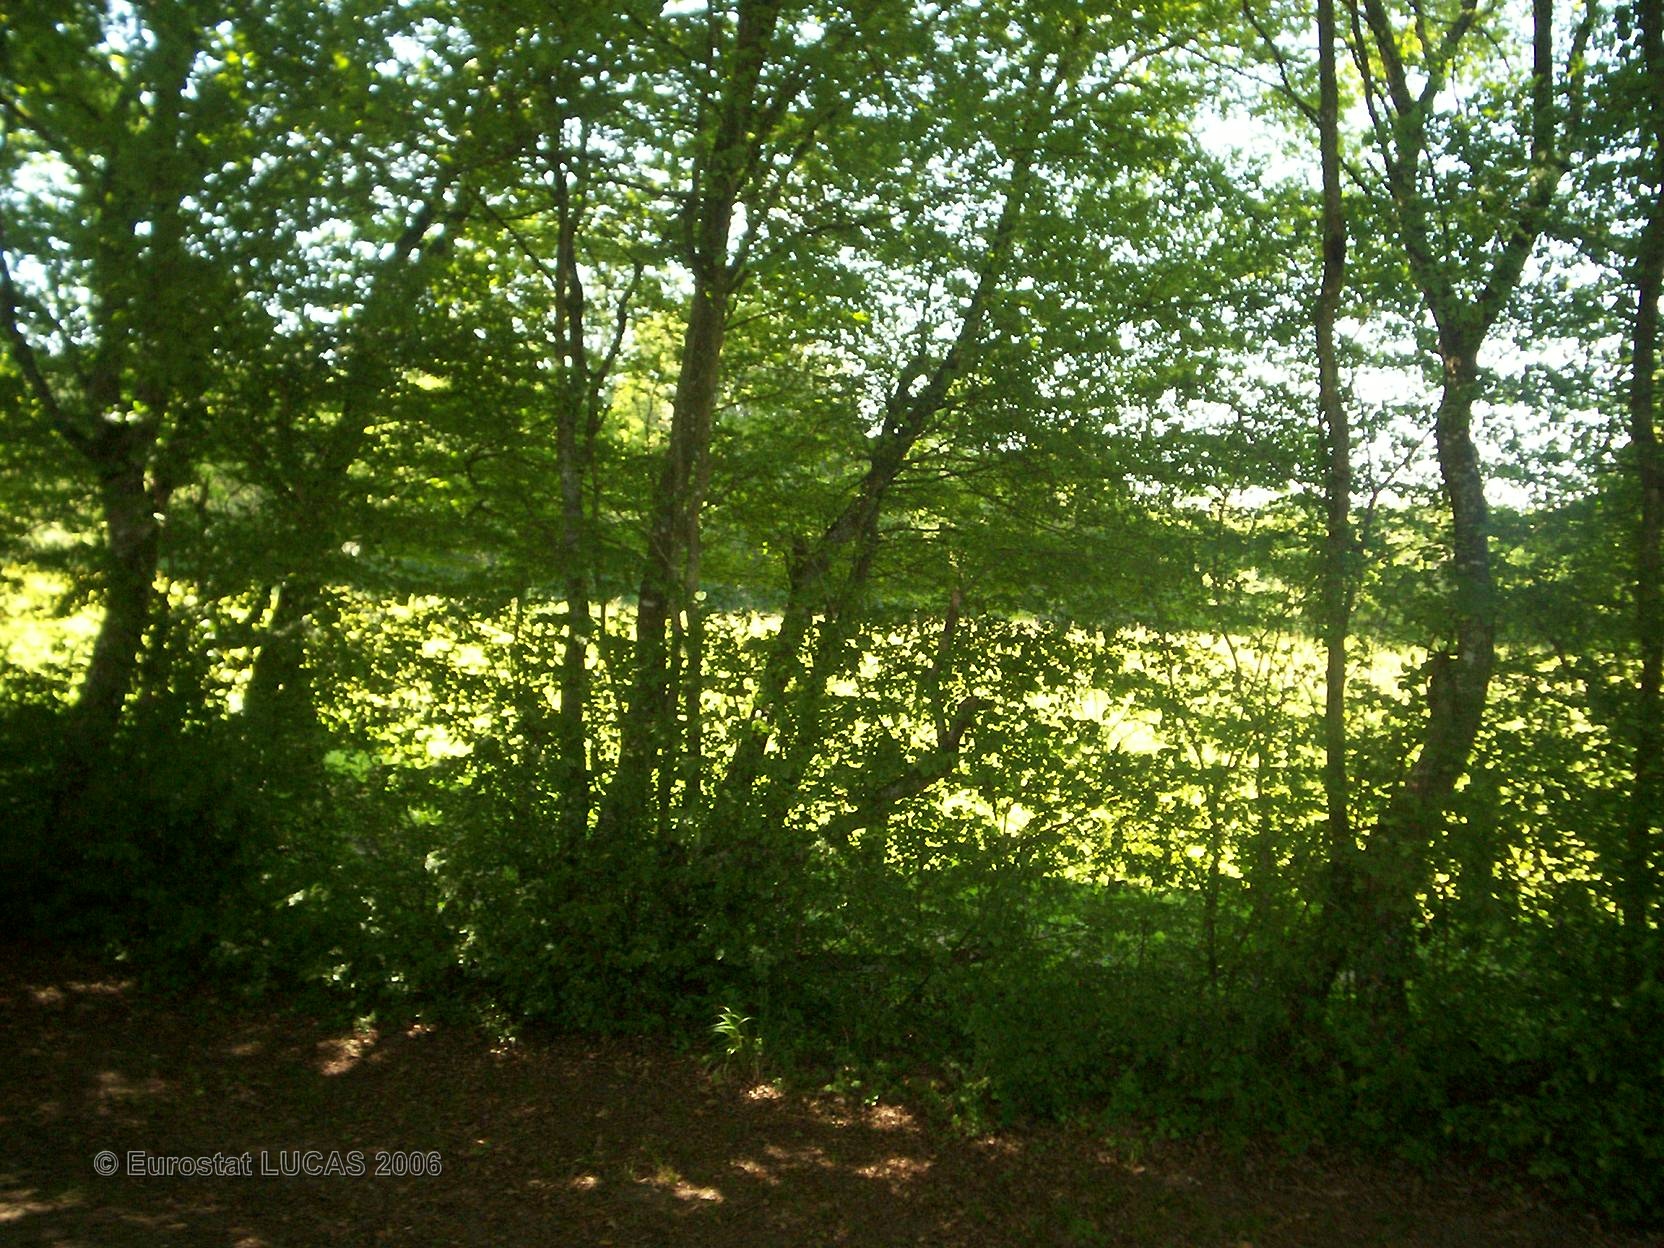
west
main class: Grassland
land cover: Grassland with sparse tree/shrub cover
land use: Agriculture (excluding fallow land and kitchen gardens)
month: June
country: FR
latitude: 46.9560
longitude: 3.0447
